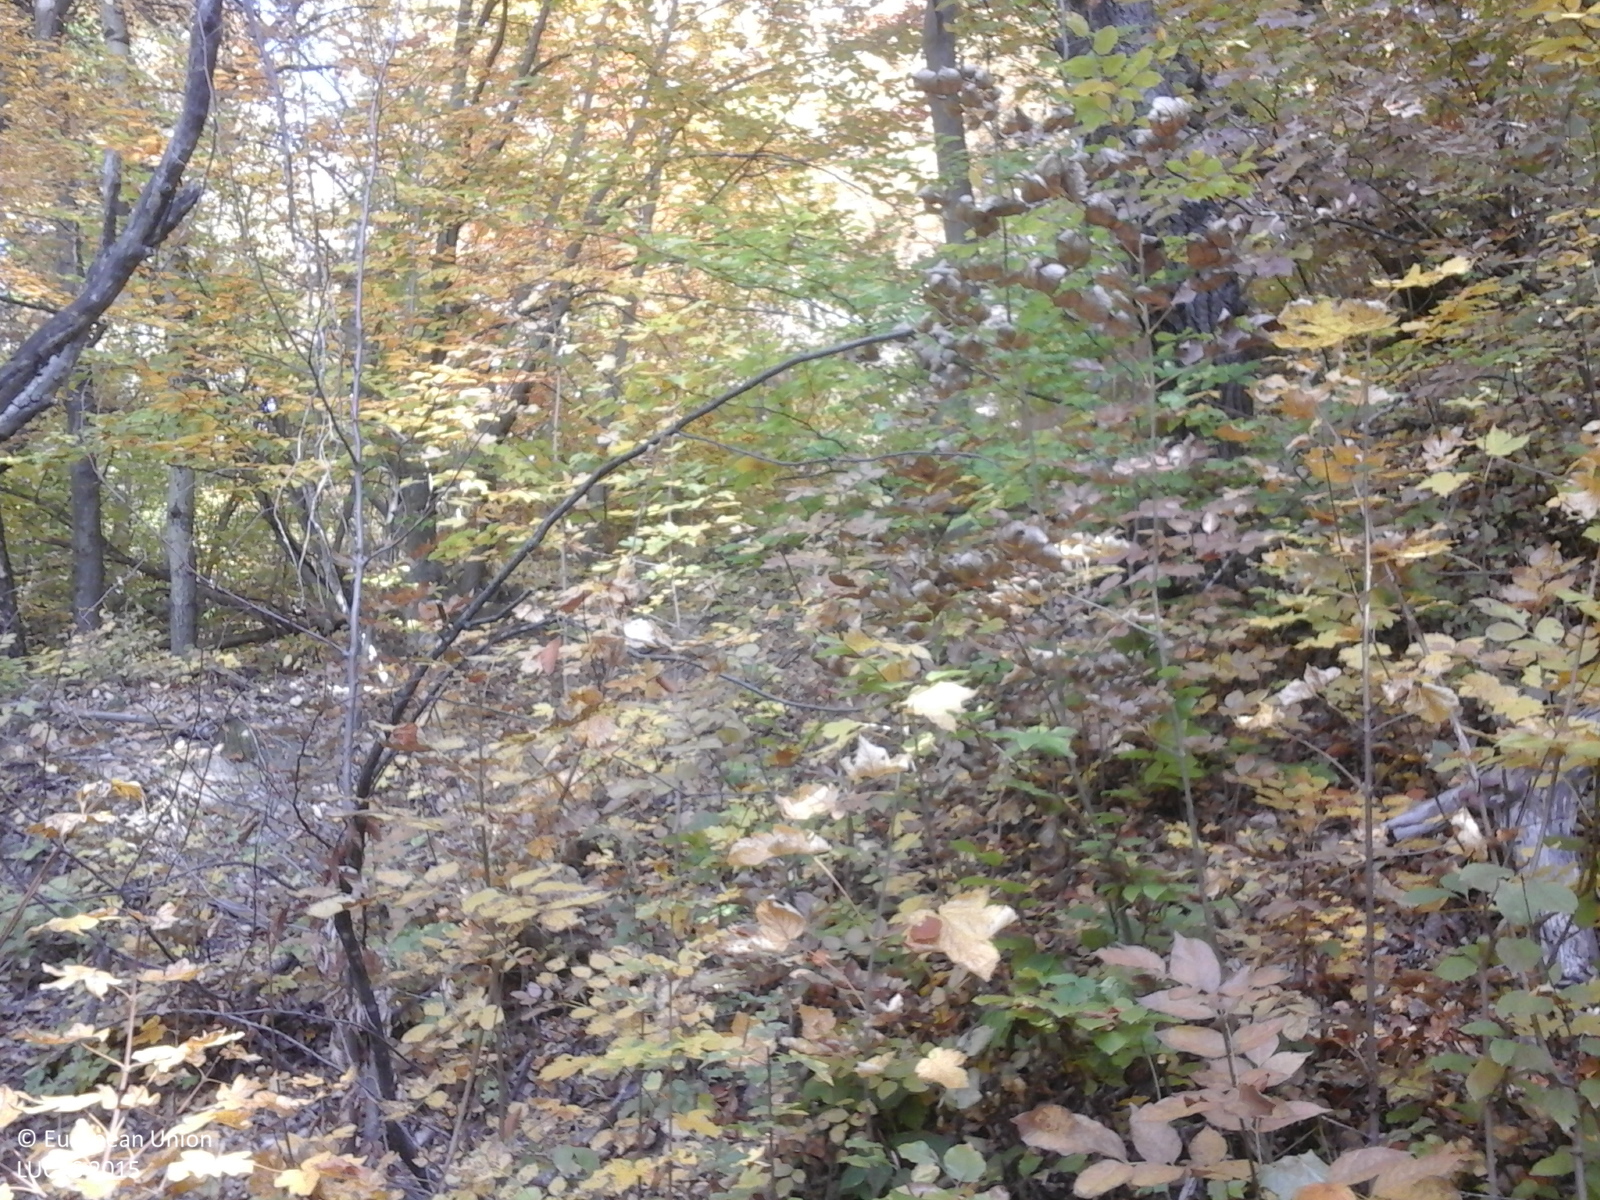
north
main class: Woodland
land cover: Broadleaved woodland
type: beech forest
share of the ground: > 75 %
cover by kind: broadleaved forest trees 100 %
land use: Forestry
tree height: > 5 m
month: October
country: RO
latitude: 45.6810
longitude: 26.9717
